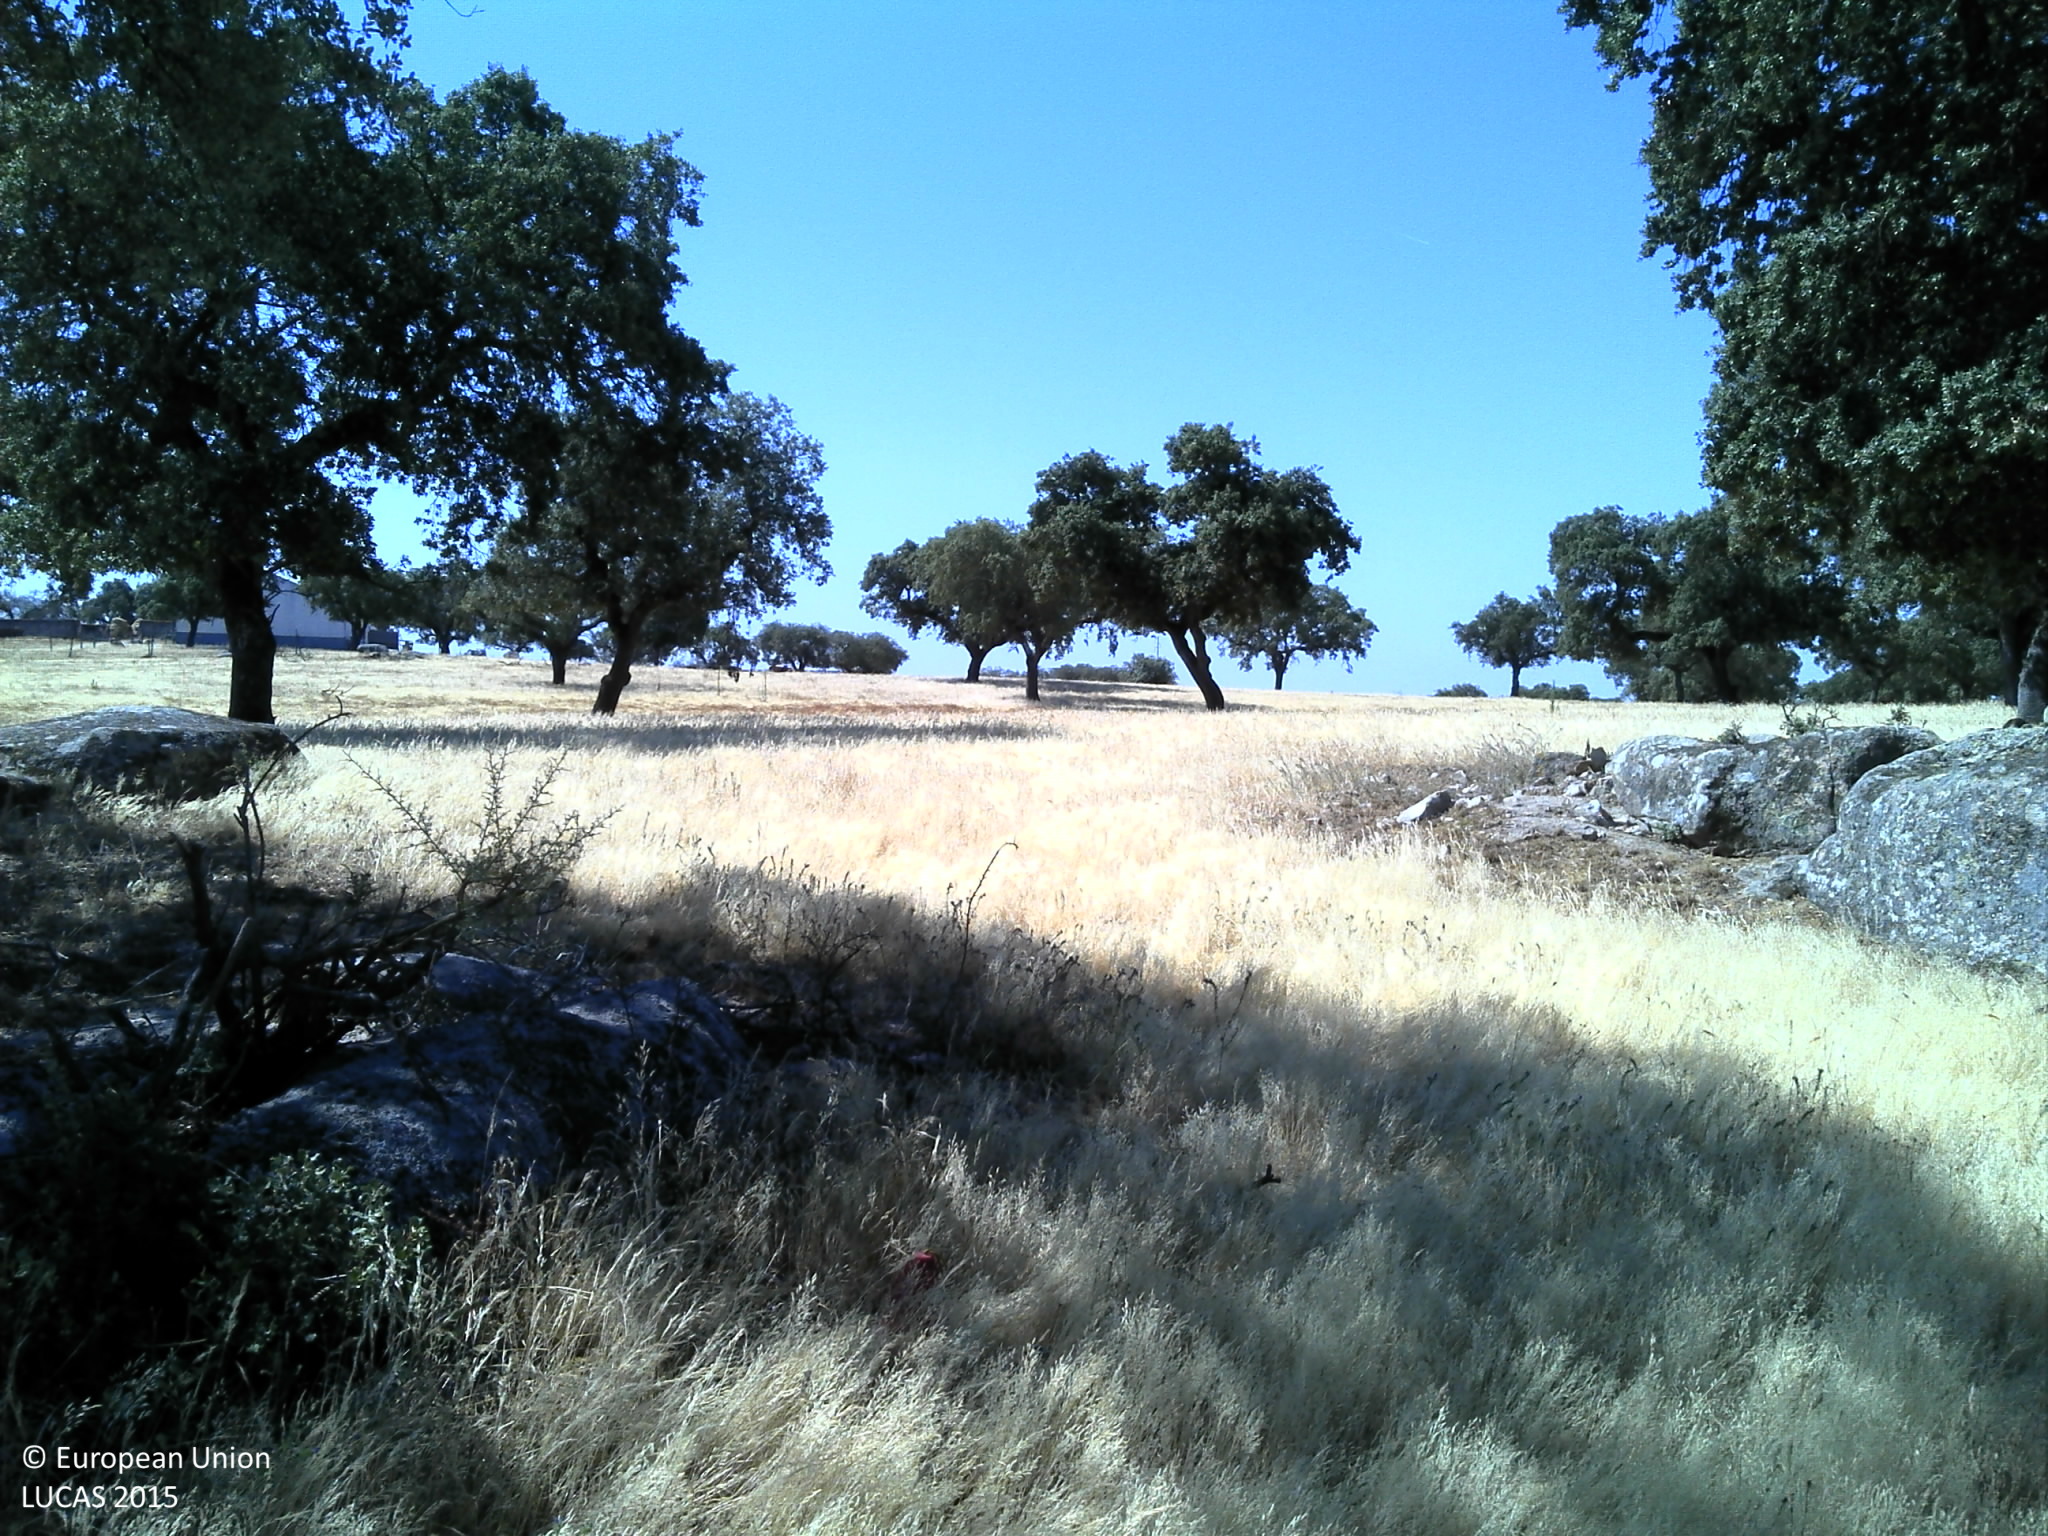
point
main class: Woodland
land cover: Broadleaved woodland
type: broadleaved evergreen forest
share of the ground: 10 - 25 %
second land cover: Grassland without tree/shrub cover
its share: 50 - 75 %
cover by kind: herbaceous plants 60 %, broadleaved forest trees 30 %, consolidated bare surface 10 %
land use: Forestry
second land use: Agriculture (excluding fallow land and kitchen gardens)
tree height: > 5 m
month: June
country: PT
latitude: 38.8610
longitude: -7.9193
